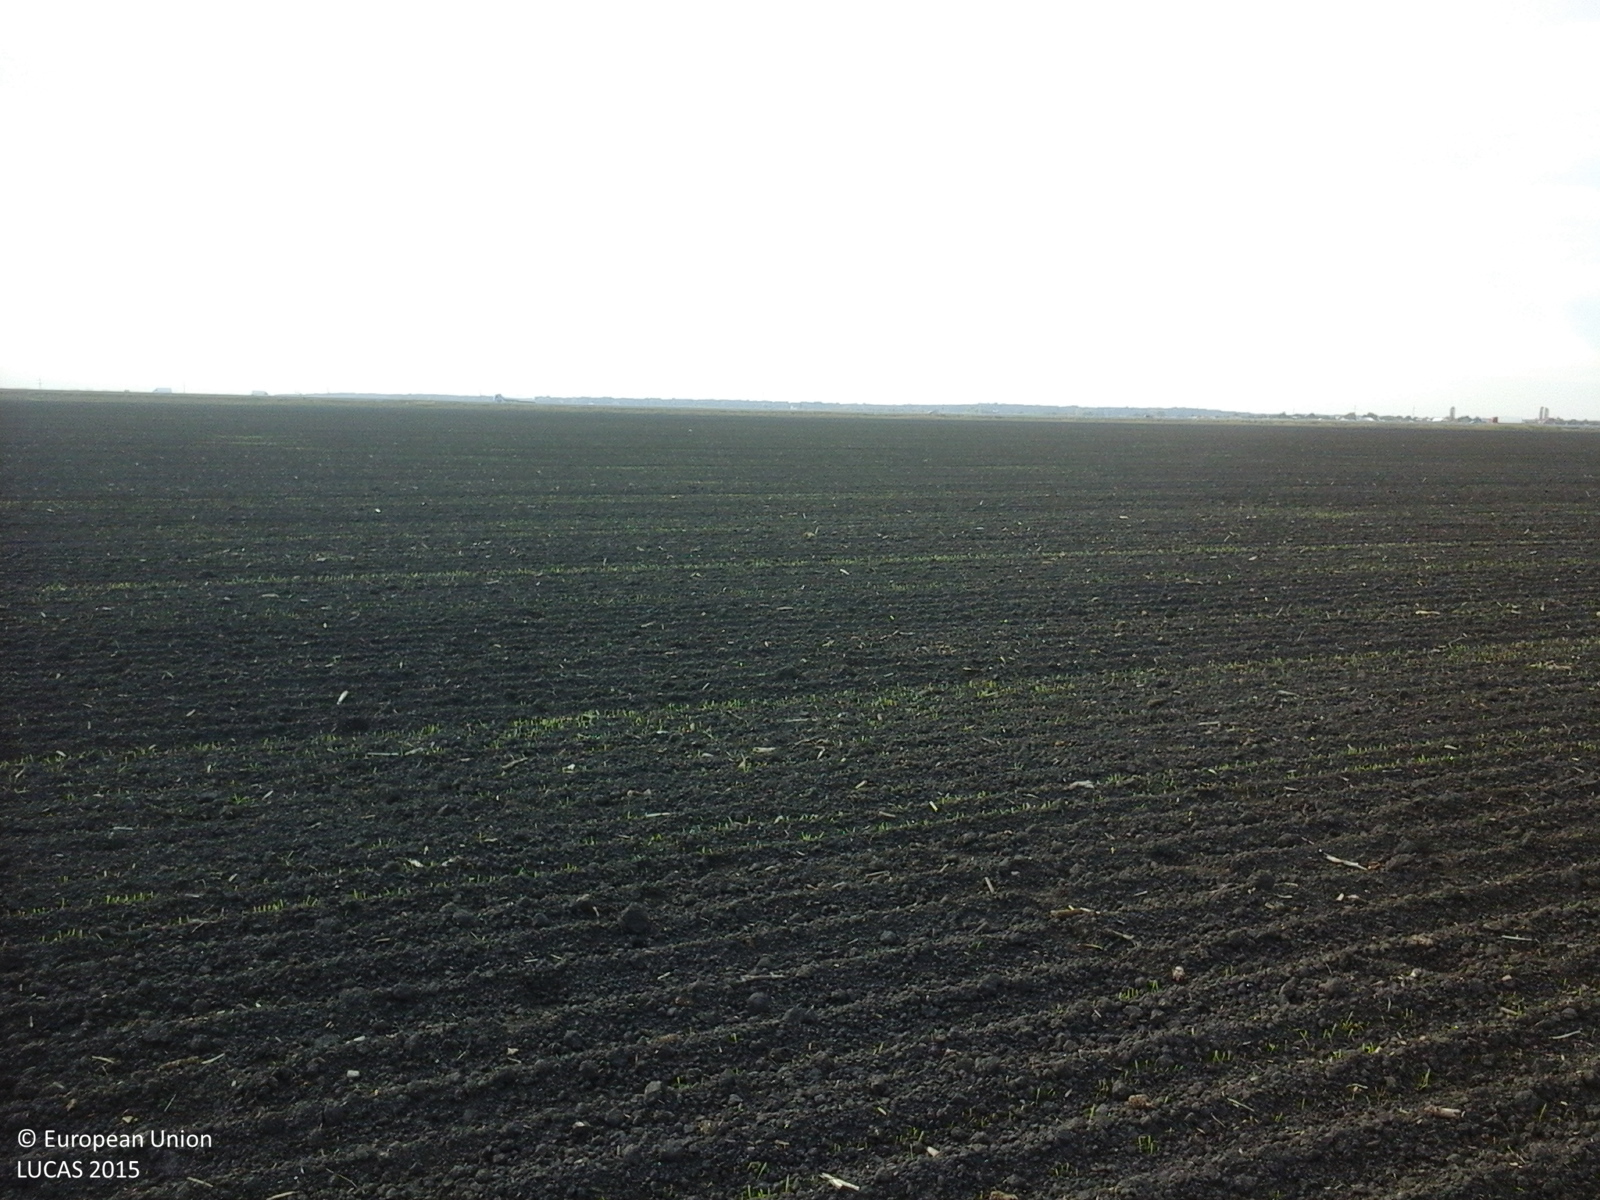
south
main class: Cropland
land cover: Maize
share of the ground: < 10 %
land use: Agriculture (excluding fallow land and kitchen gardens)
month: October
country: RO
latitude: 44.8867
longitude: 26.0744
